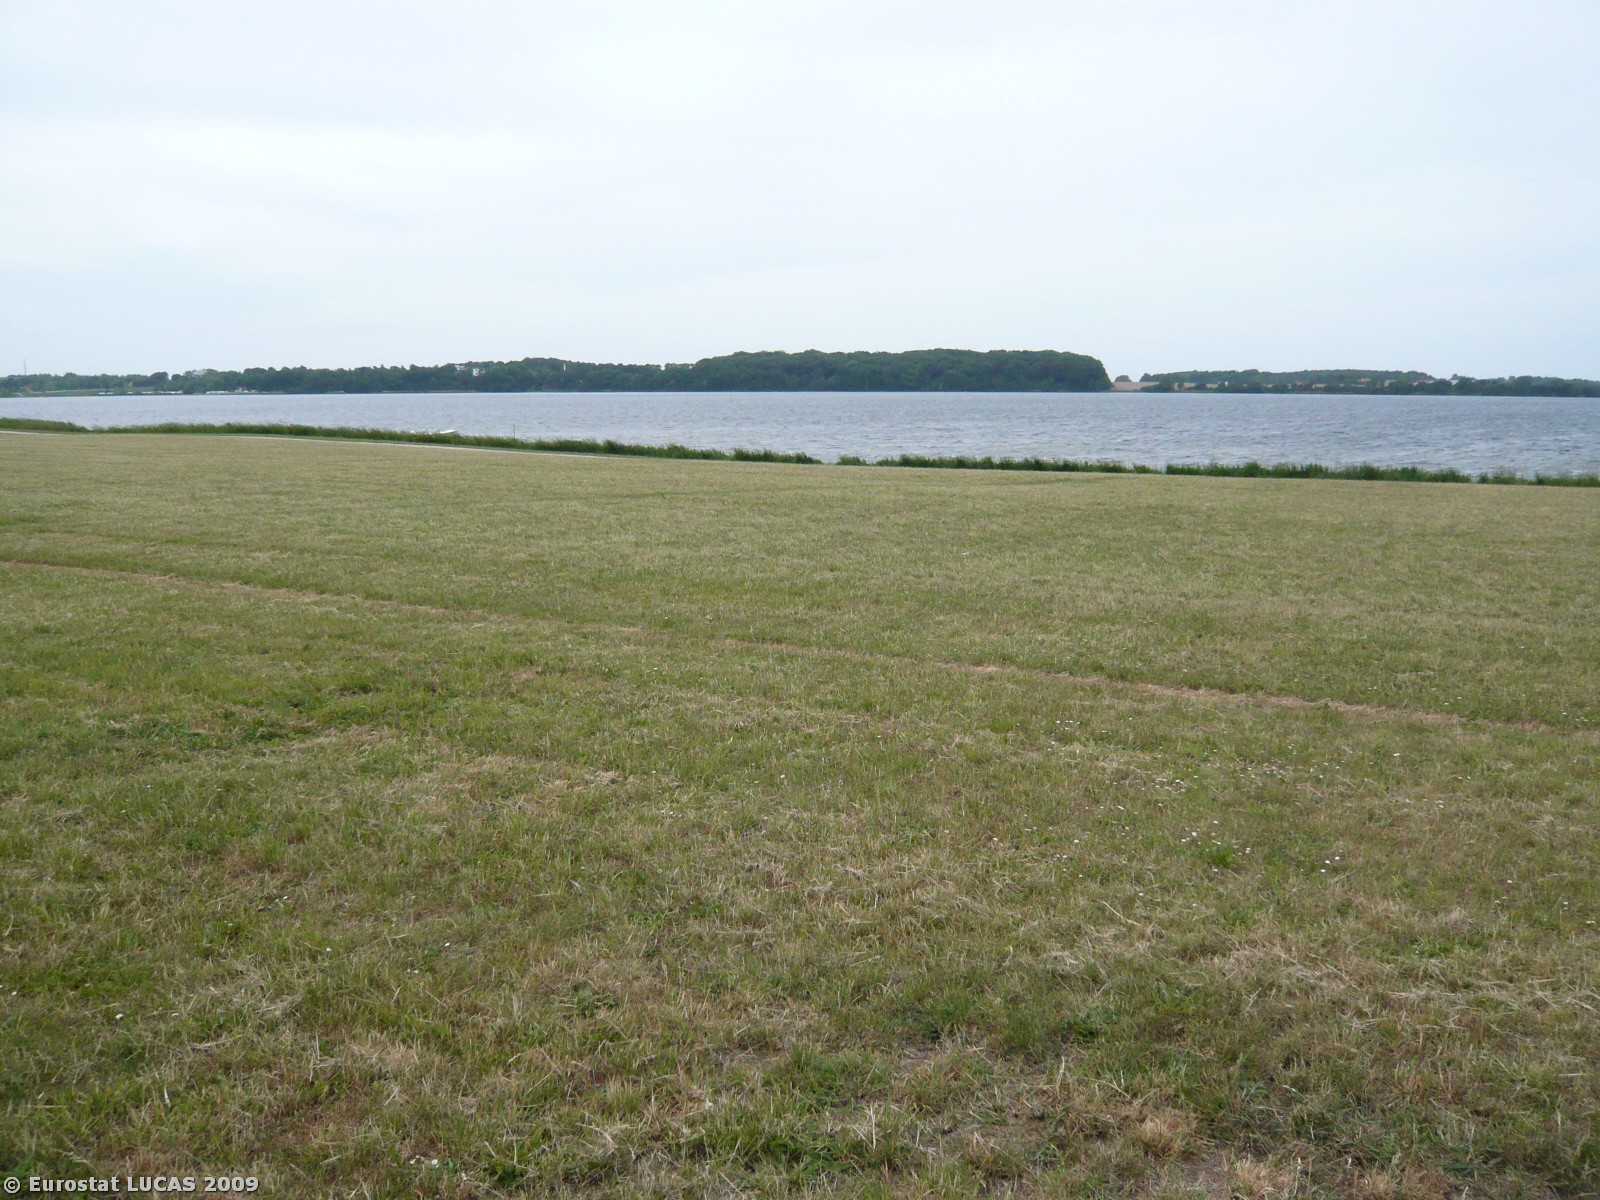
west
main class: Grassland
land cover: Grassland without tree/shrub cover
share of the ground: > 75 %
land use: Amenities, museums, leisure
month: June
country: DK
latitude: 55.2643
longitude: 11.3051
